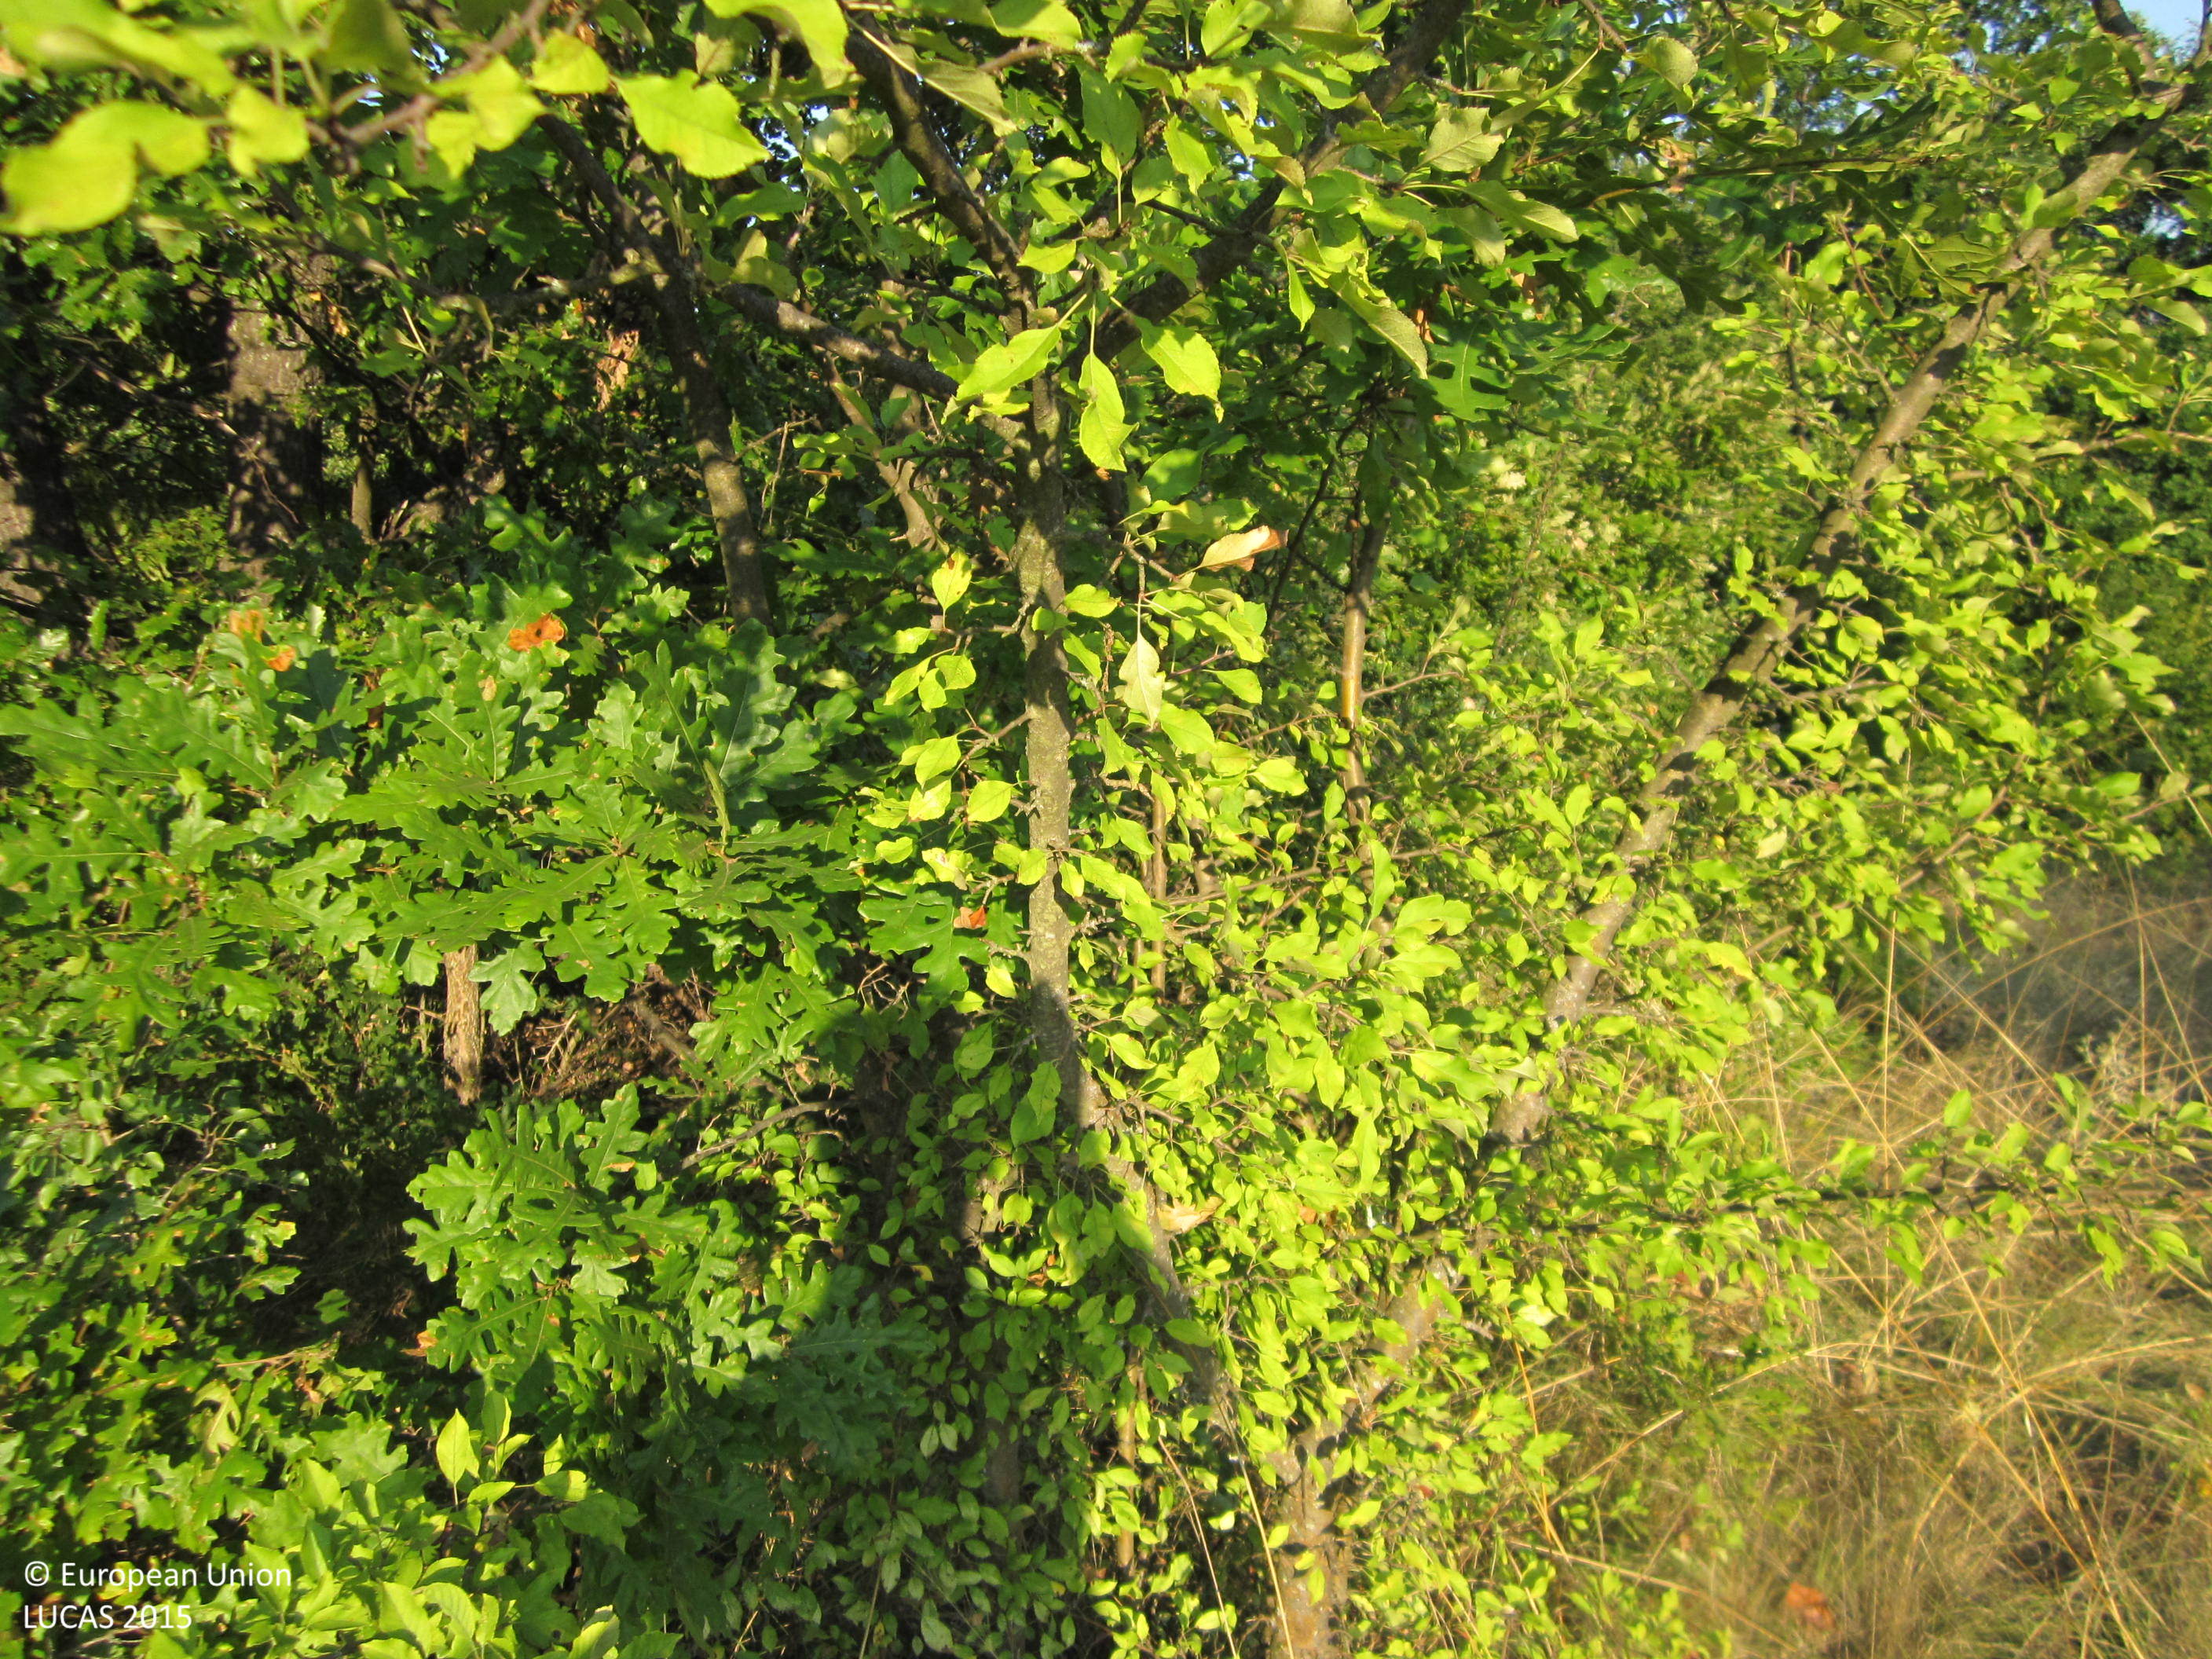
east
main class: Woodland
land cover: Broadleaved woodland
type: mesophytic deciduous forest
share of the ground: 25 - 50 %
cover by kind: herbaceous plants 60 %, broadleaved forest trees 35 %, shrubs 5 %
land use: Semi-natural and natural areas not in use
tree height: > 5 m
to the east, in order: Broadleaved woodland; Grass margins; Tracks; Grass margins; Common wheat; Grassland without tree/shrub cover; Common wheat; Grassland with sparse tree/shrub cover; Common wheat
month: September
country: BG
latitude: 42.8392
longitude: 27.1312
